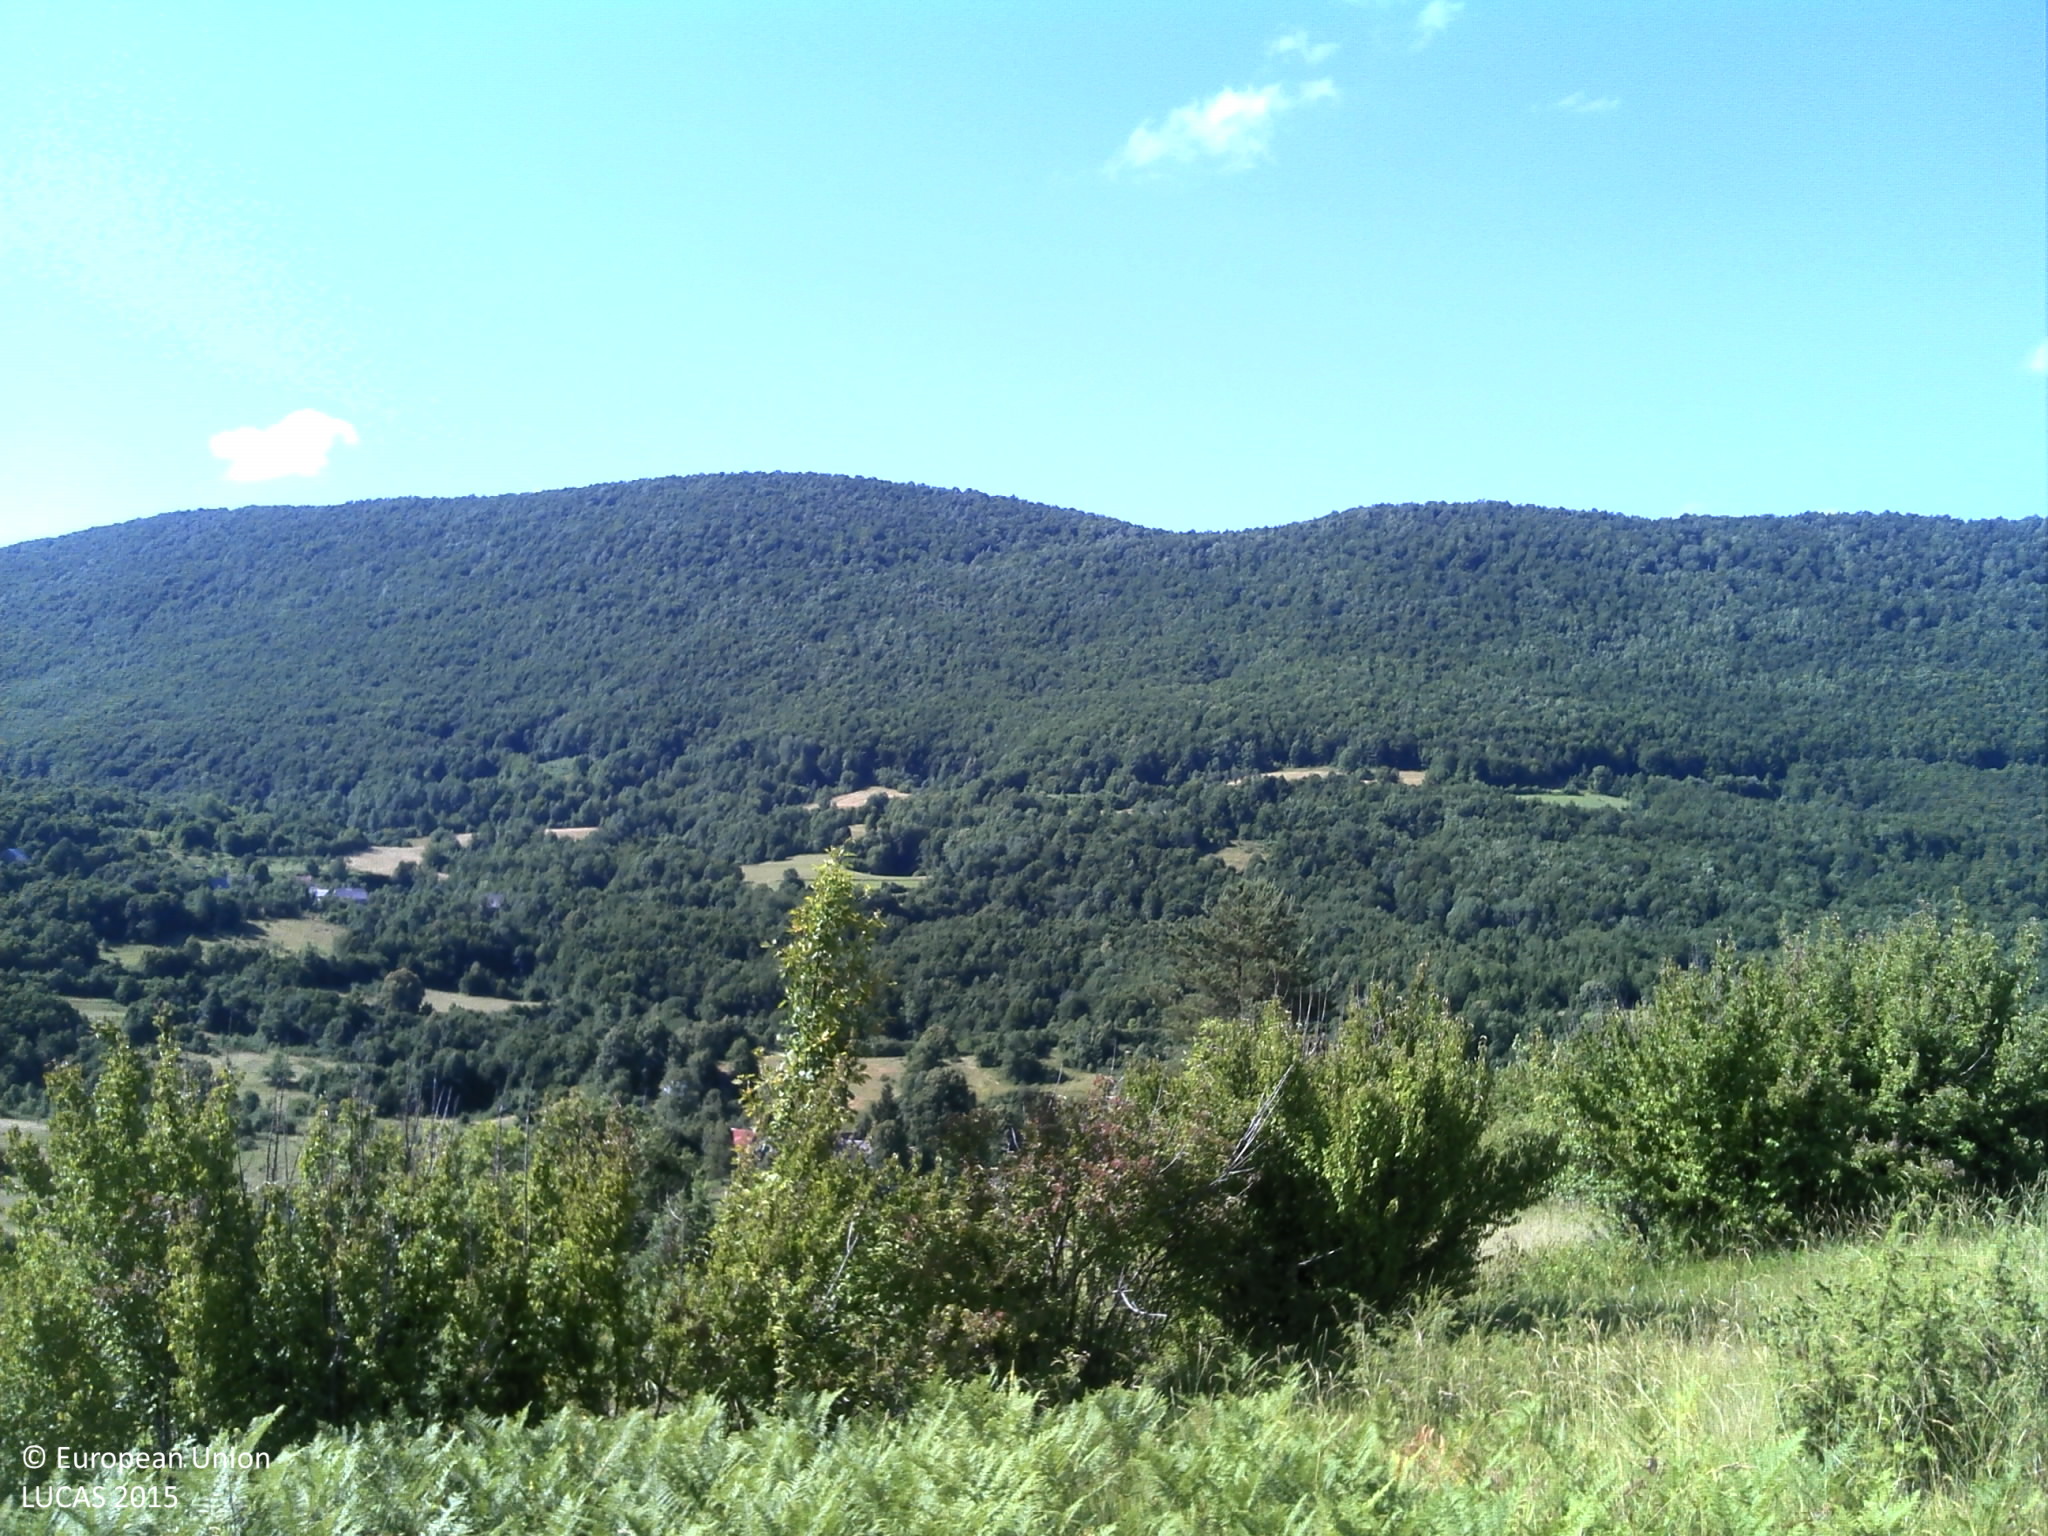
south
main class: Grassland
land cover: Grassland with sparse tree/shrub cover
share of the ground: > 75 %
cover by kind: herbaceous plants 80 %, shrubs 10 %, broadleaved forest trees 5 %, unconsolidated bare surface 5 %
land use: Abandoned areas
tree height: < 5 m
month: July
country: HR
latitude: 44.8553
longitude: 15.1443
